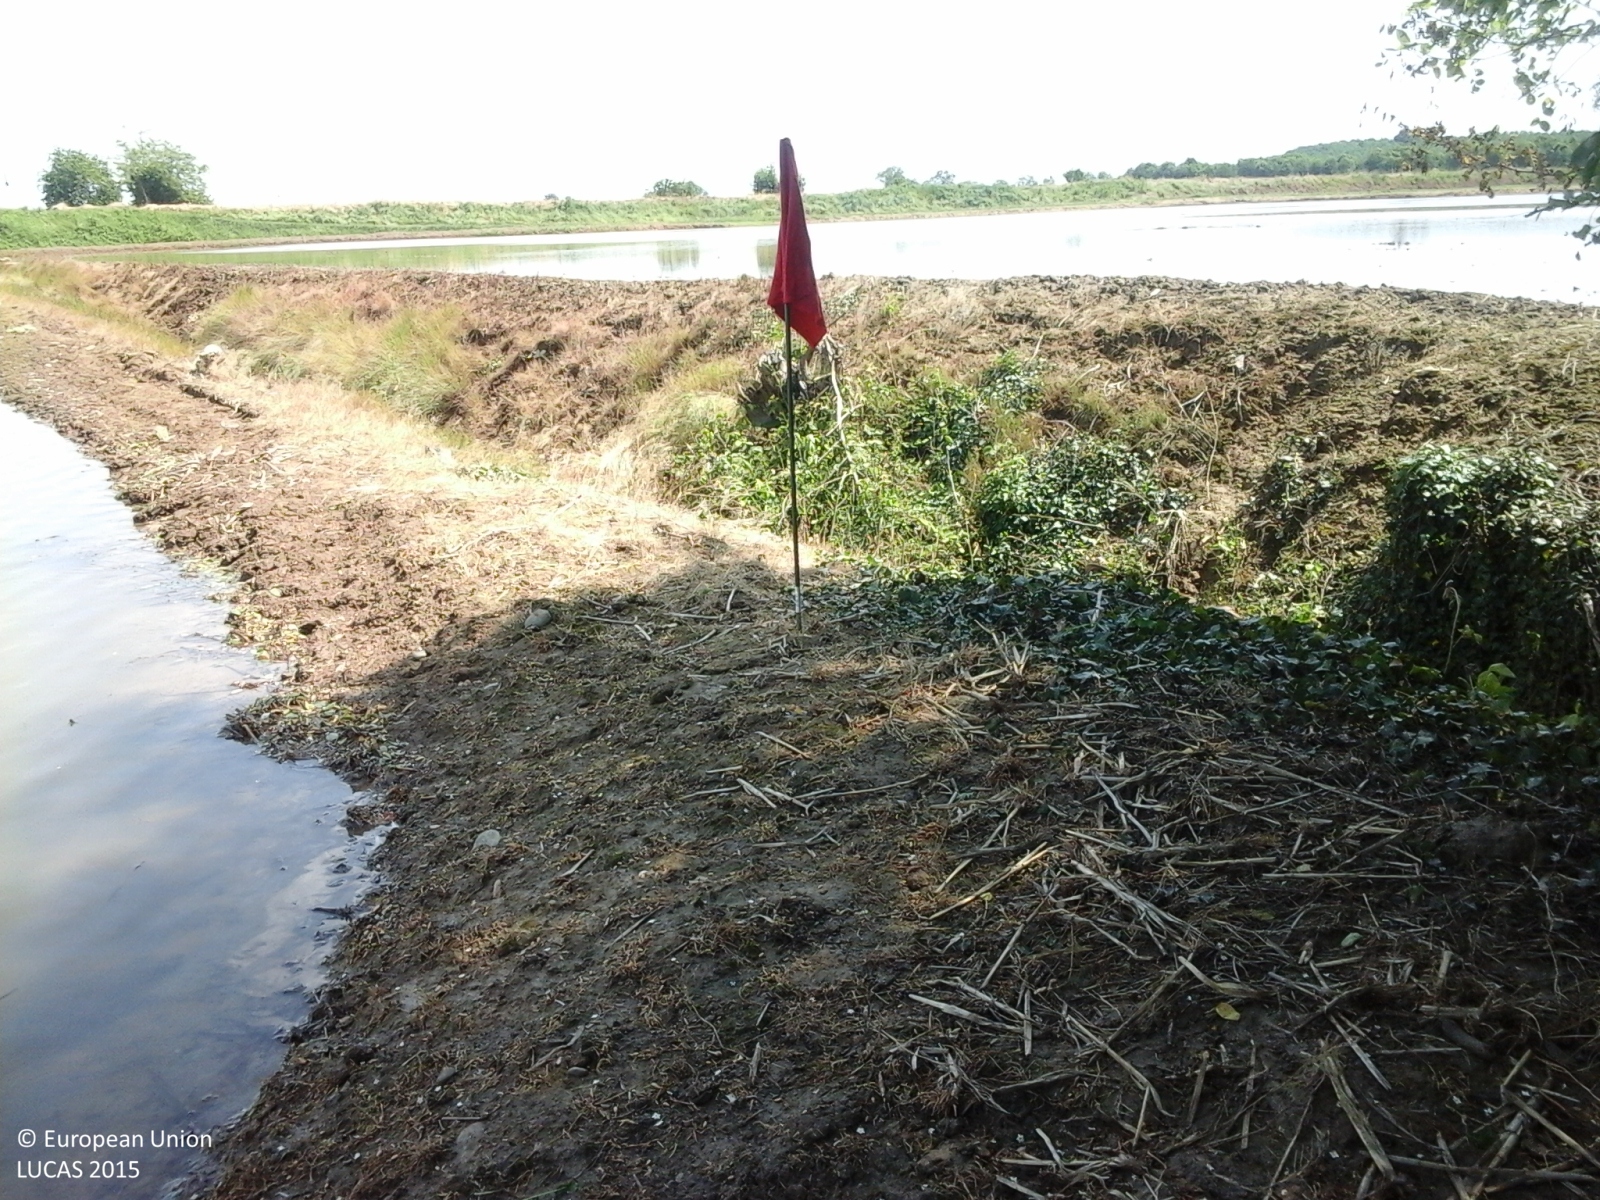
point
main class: Cropland
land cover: Rice
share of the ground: 10 - 25 %
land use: Agriculture (excluding fallow land and kitchen gardens)
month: May
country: IT
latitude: 45.2188
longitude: 8.2076
